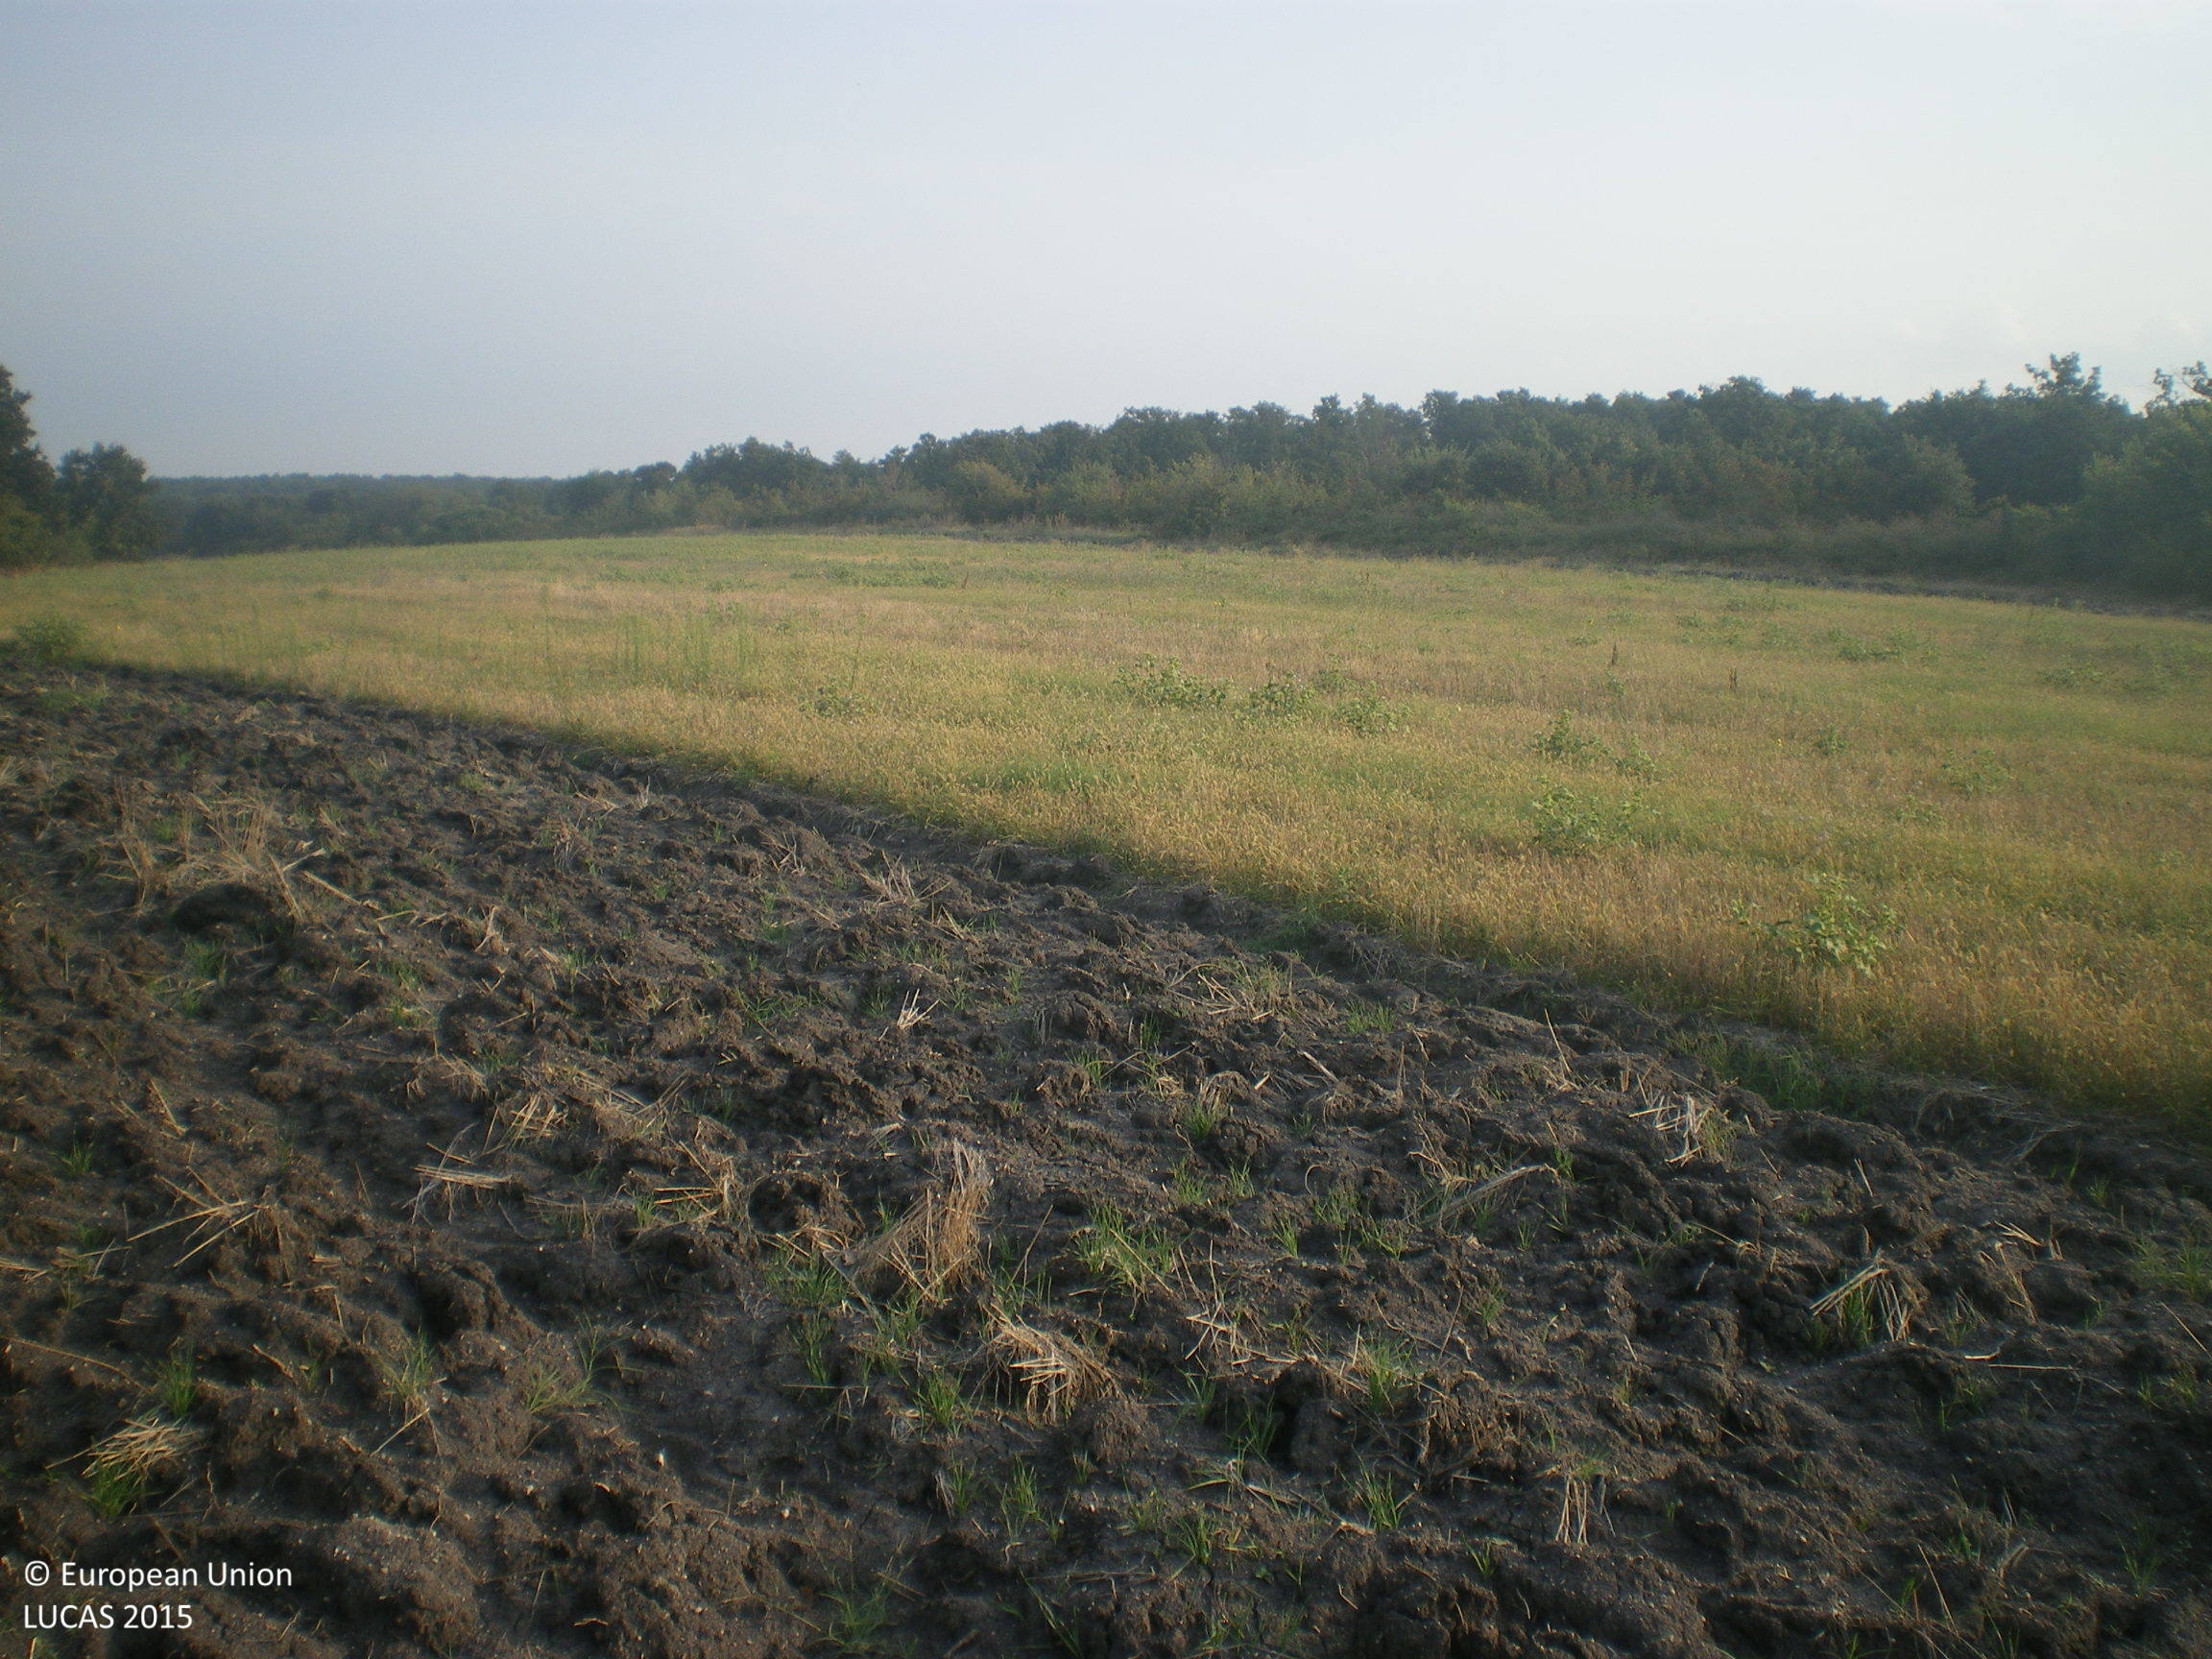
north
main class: Woodland
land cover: Broadleaved woodland
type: mesophytic deciduous forest
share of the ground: > 75 %
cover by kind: broadleaved forest trees 80 %, shrubs 20 %
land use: Forestry
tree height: > 5 m
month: September
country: BG
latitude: 42.0669
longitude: 25.7941
